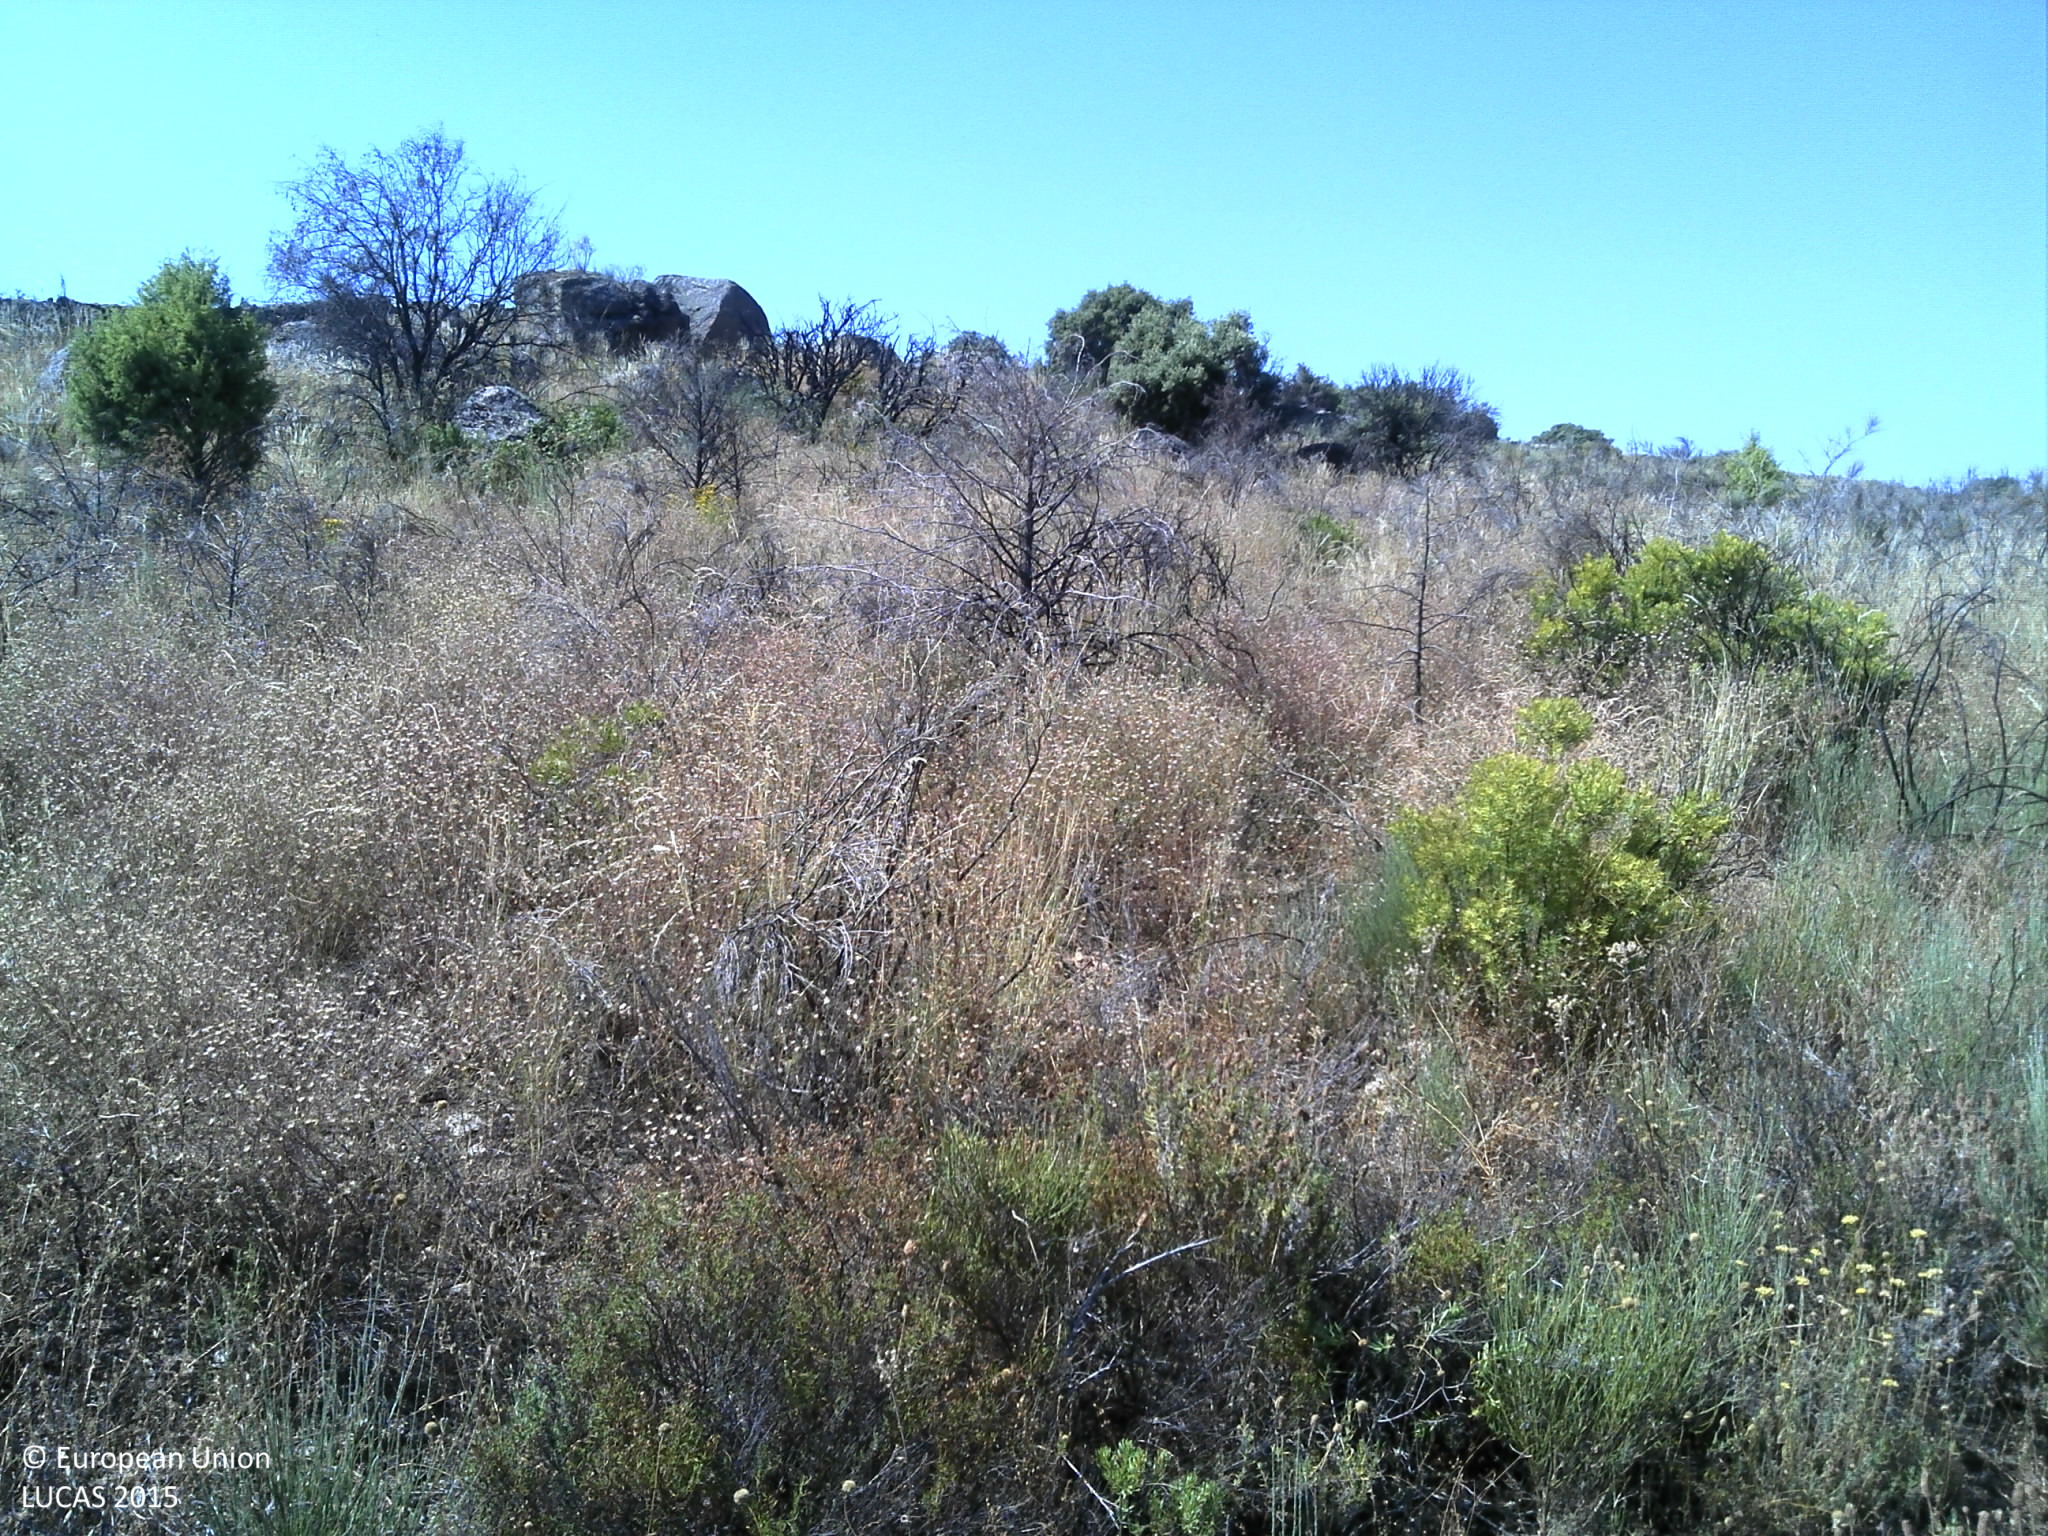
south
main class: Shrubland
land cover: Shrubland with sparse tree cover
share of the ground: > 75 %
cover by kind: shrubs 95 %, coniferous forest trees 5 %
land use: Semi-natural and natural areas not in use
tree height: < 5 m
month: June
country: PT
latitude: 40.9475
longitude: -6.8885
